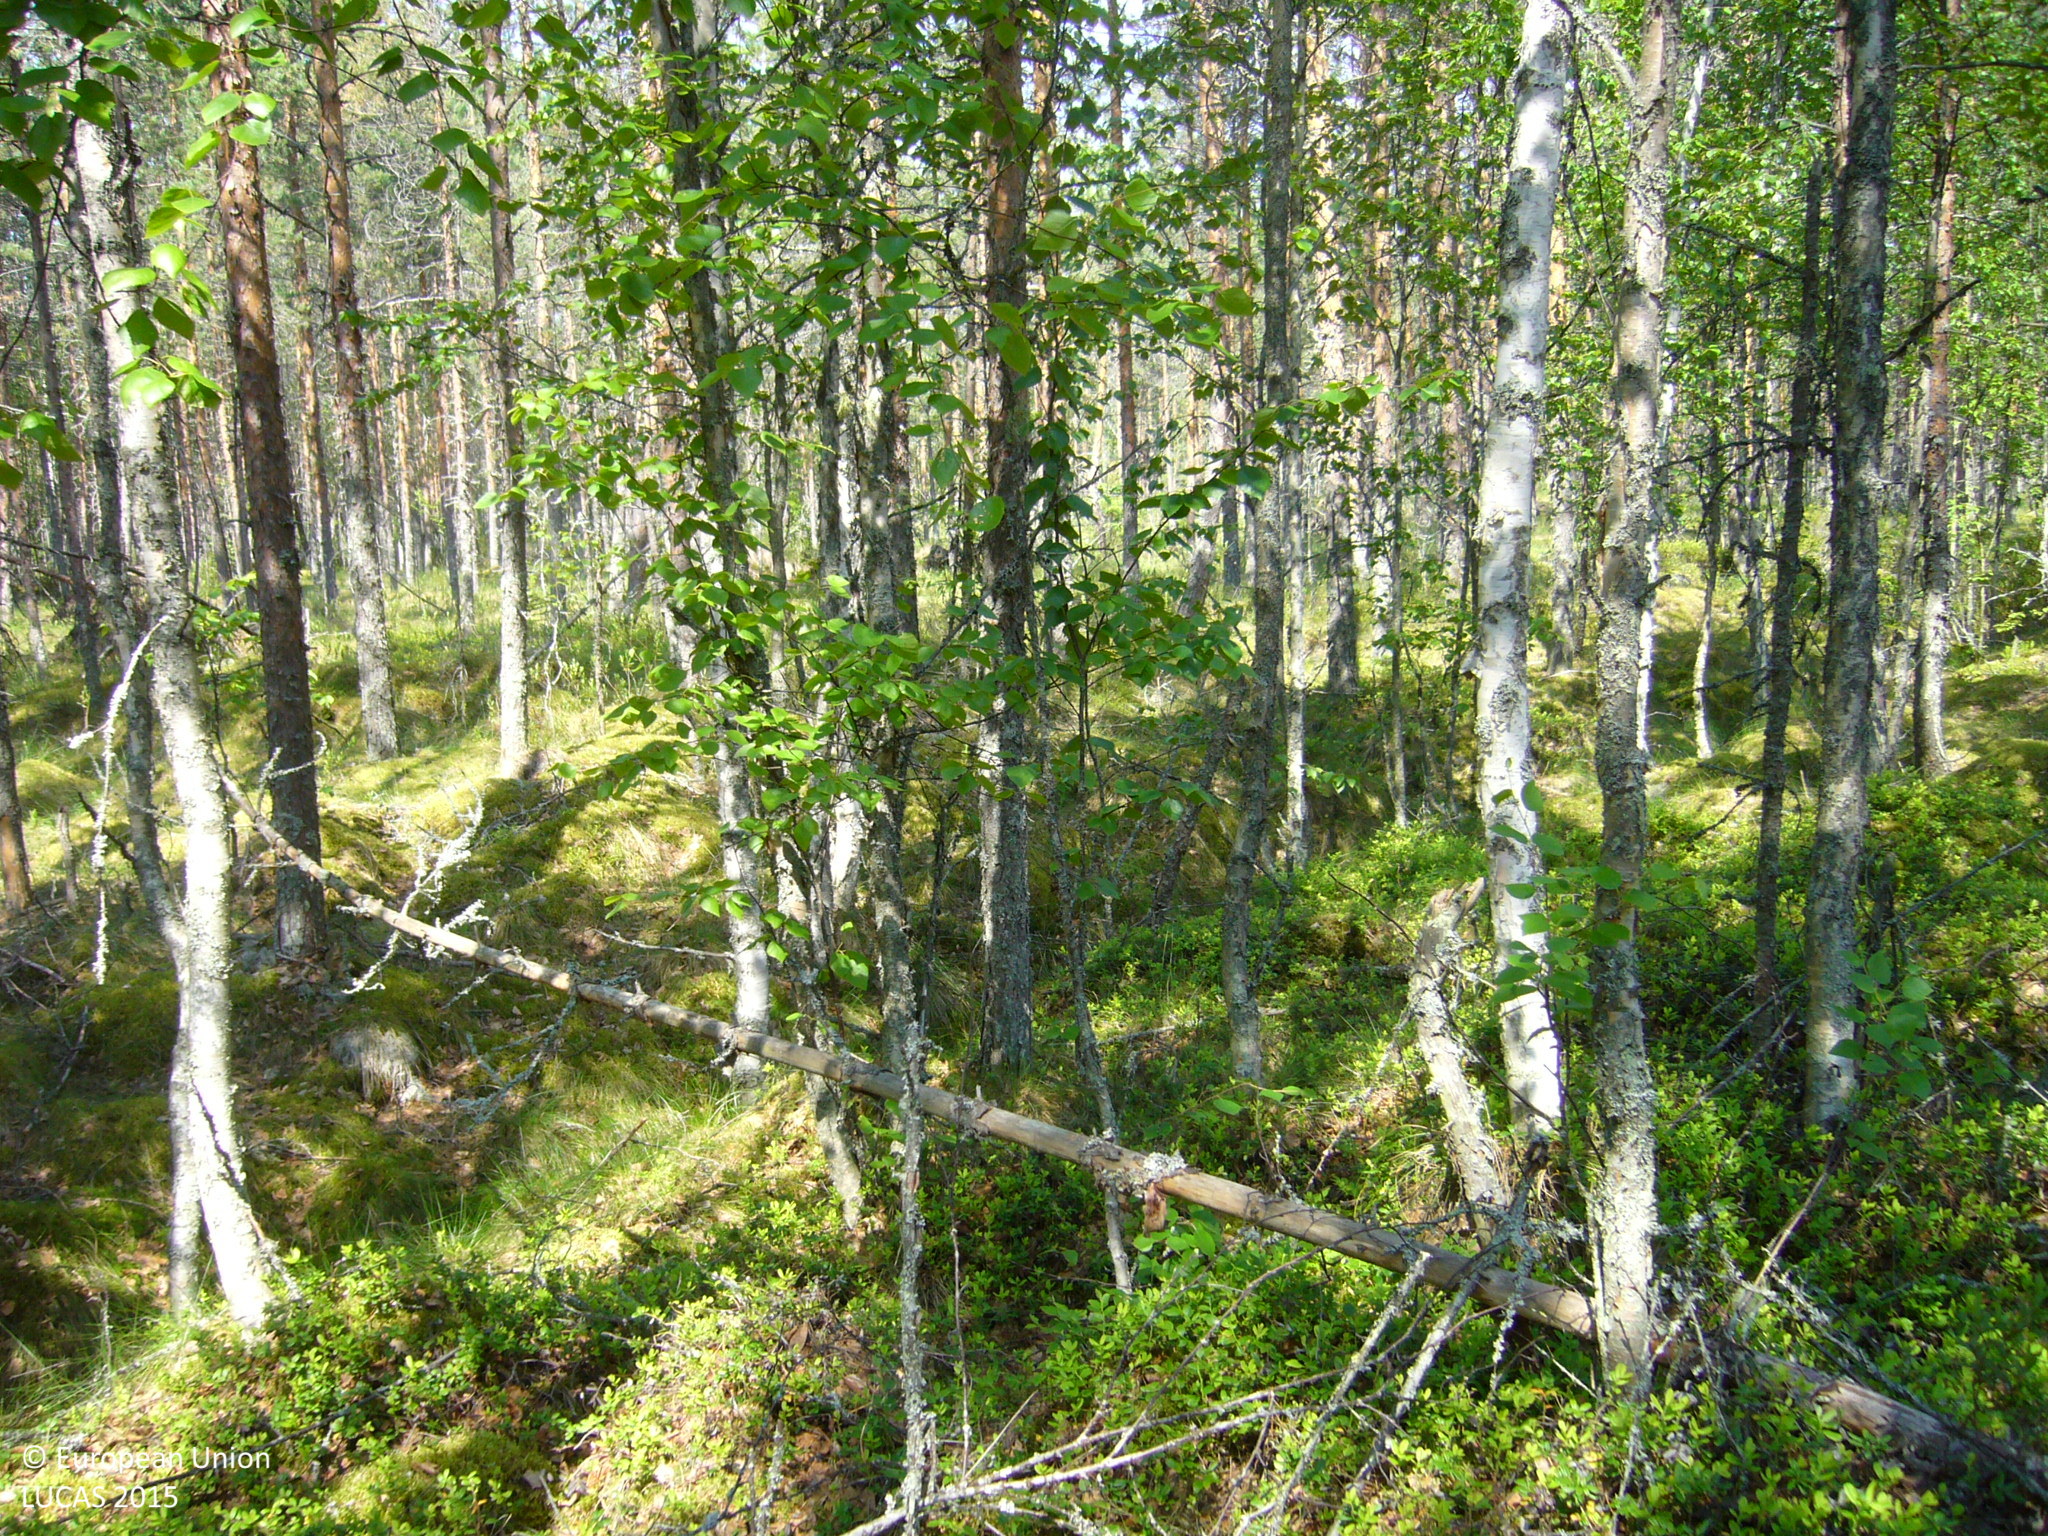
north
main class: Woodland
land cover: Pine dominated coniferous woodland
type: boreal forest
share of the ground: > 75 %
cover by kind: coniferous forest trees 70 %, shrubs 20 %, broadleaved forest trees 10 %
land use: Forestry
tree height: > 5 m
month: July
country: FI
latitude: 63.5765
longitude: 25.8393
